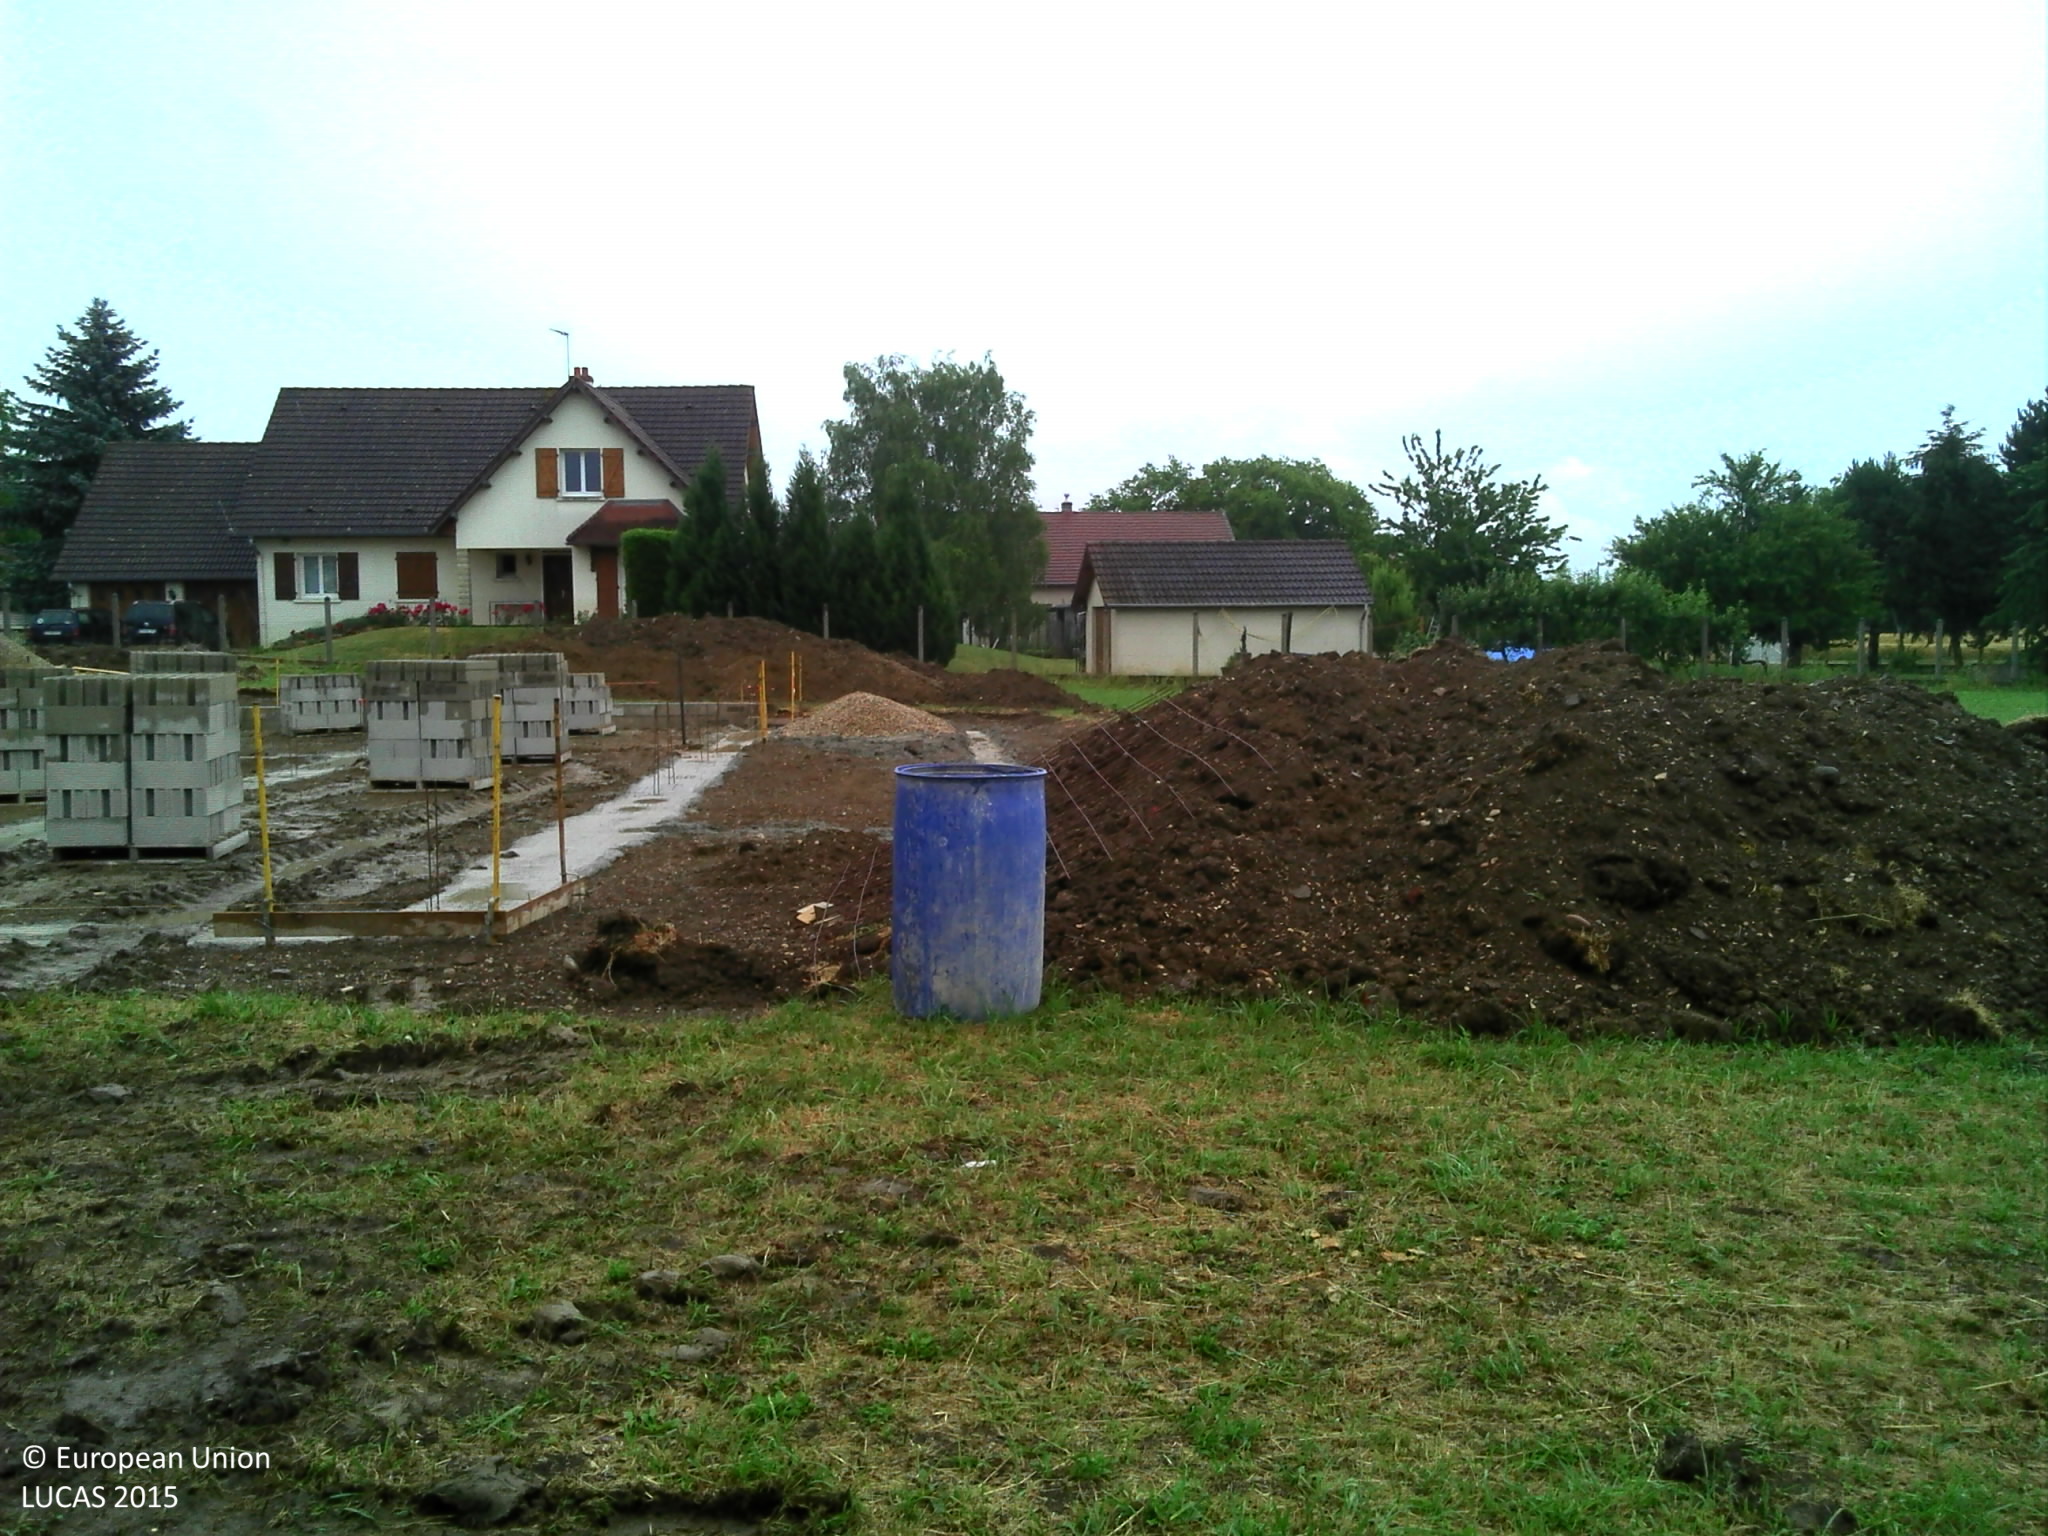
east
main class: Grassland
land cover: Grassland without tree/shrub cover
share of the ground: > 75 %
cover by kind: herbaceous plants 100 %
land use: Residential
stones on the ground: < 10 %
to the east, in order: Grassland without tree/shrub cover; Artificial constructions in urban areas
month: June
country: FR
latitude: 47.0092
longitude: 5.3847
